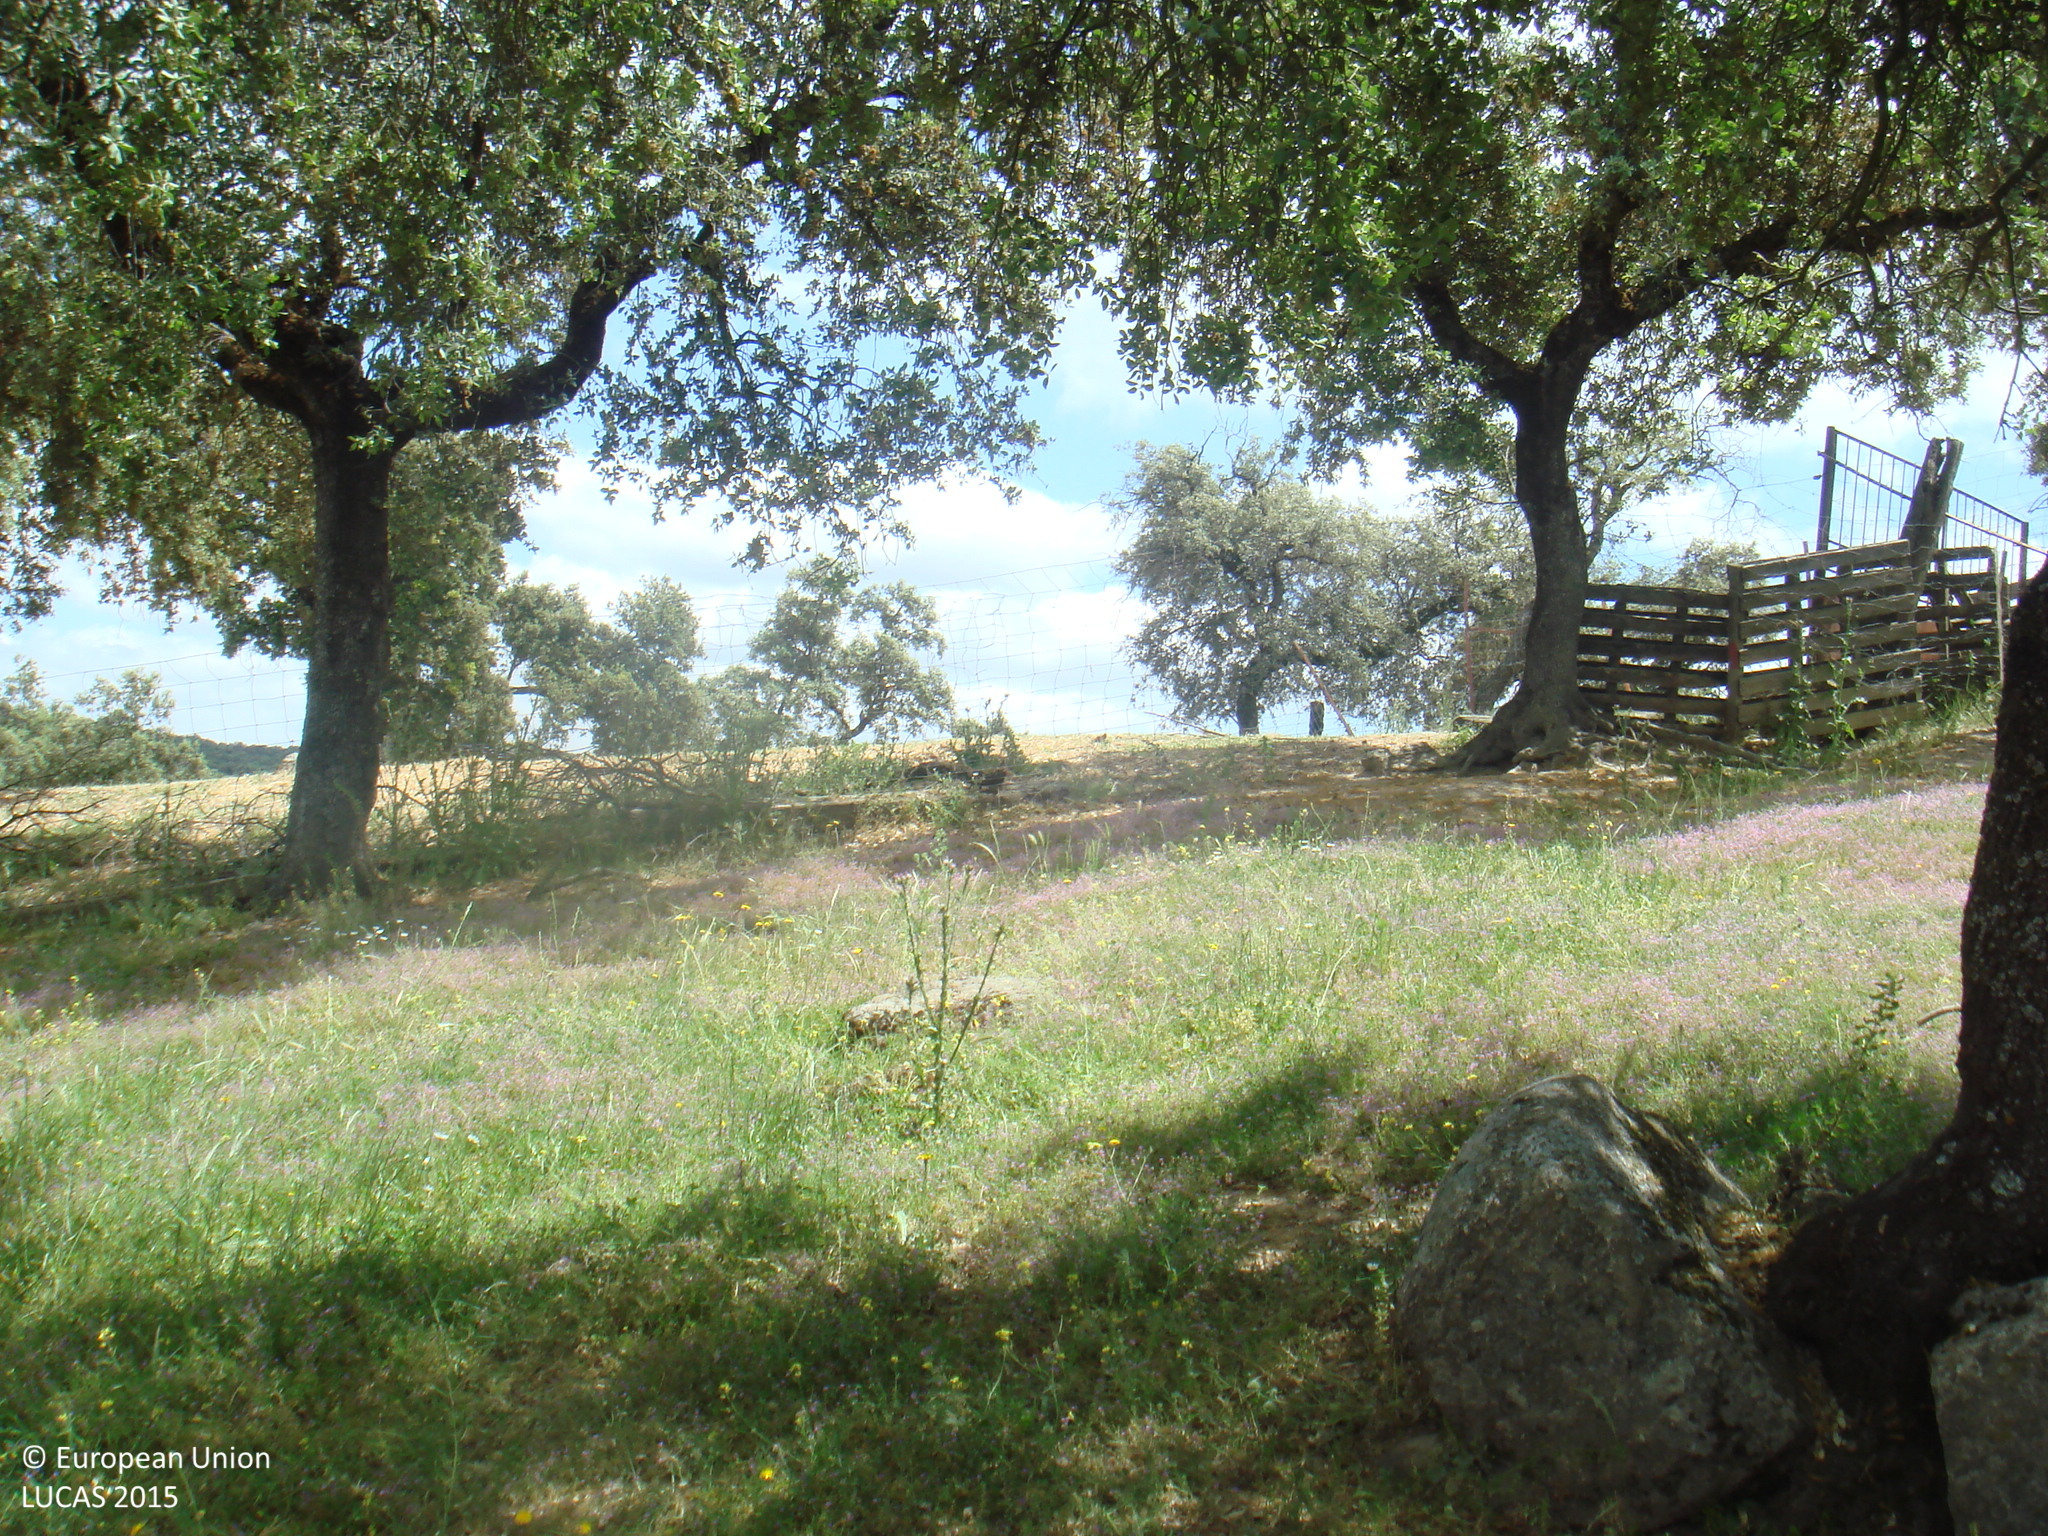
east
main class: Woodland
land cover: Broadleaved woodland
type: broadleaved evergreen forest
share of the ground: 50 - 75 %
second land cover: Spontaneously vegetated surfaces
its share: > 75 %
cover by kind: herbaceous plants 60 %, broadleaved forest trees 40 %
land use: Forestry
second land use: Agriculture (excluding fallow land and kitchen gardens)
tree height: > 5 m
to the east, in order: Broadleaved woodland; Spontaneously vegetated surfaces; Rock outcrops; Fences; Broadleaved woodland; Grassland with sparse tree/shrub cover; Tracks; Broadleaved woodland; Grassland with sparse tree/shrub cover; Rock outcrops; Broadleaved woodland; Grassland with sparse tree/shrub cover; Fences; Shrubland with sparse tree cover
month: May
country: ES
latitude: 38.3111
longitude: -4.3224
